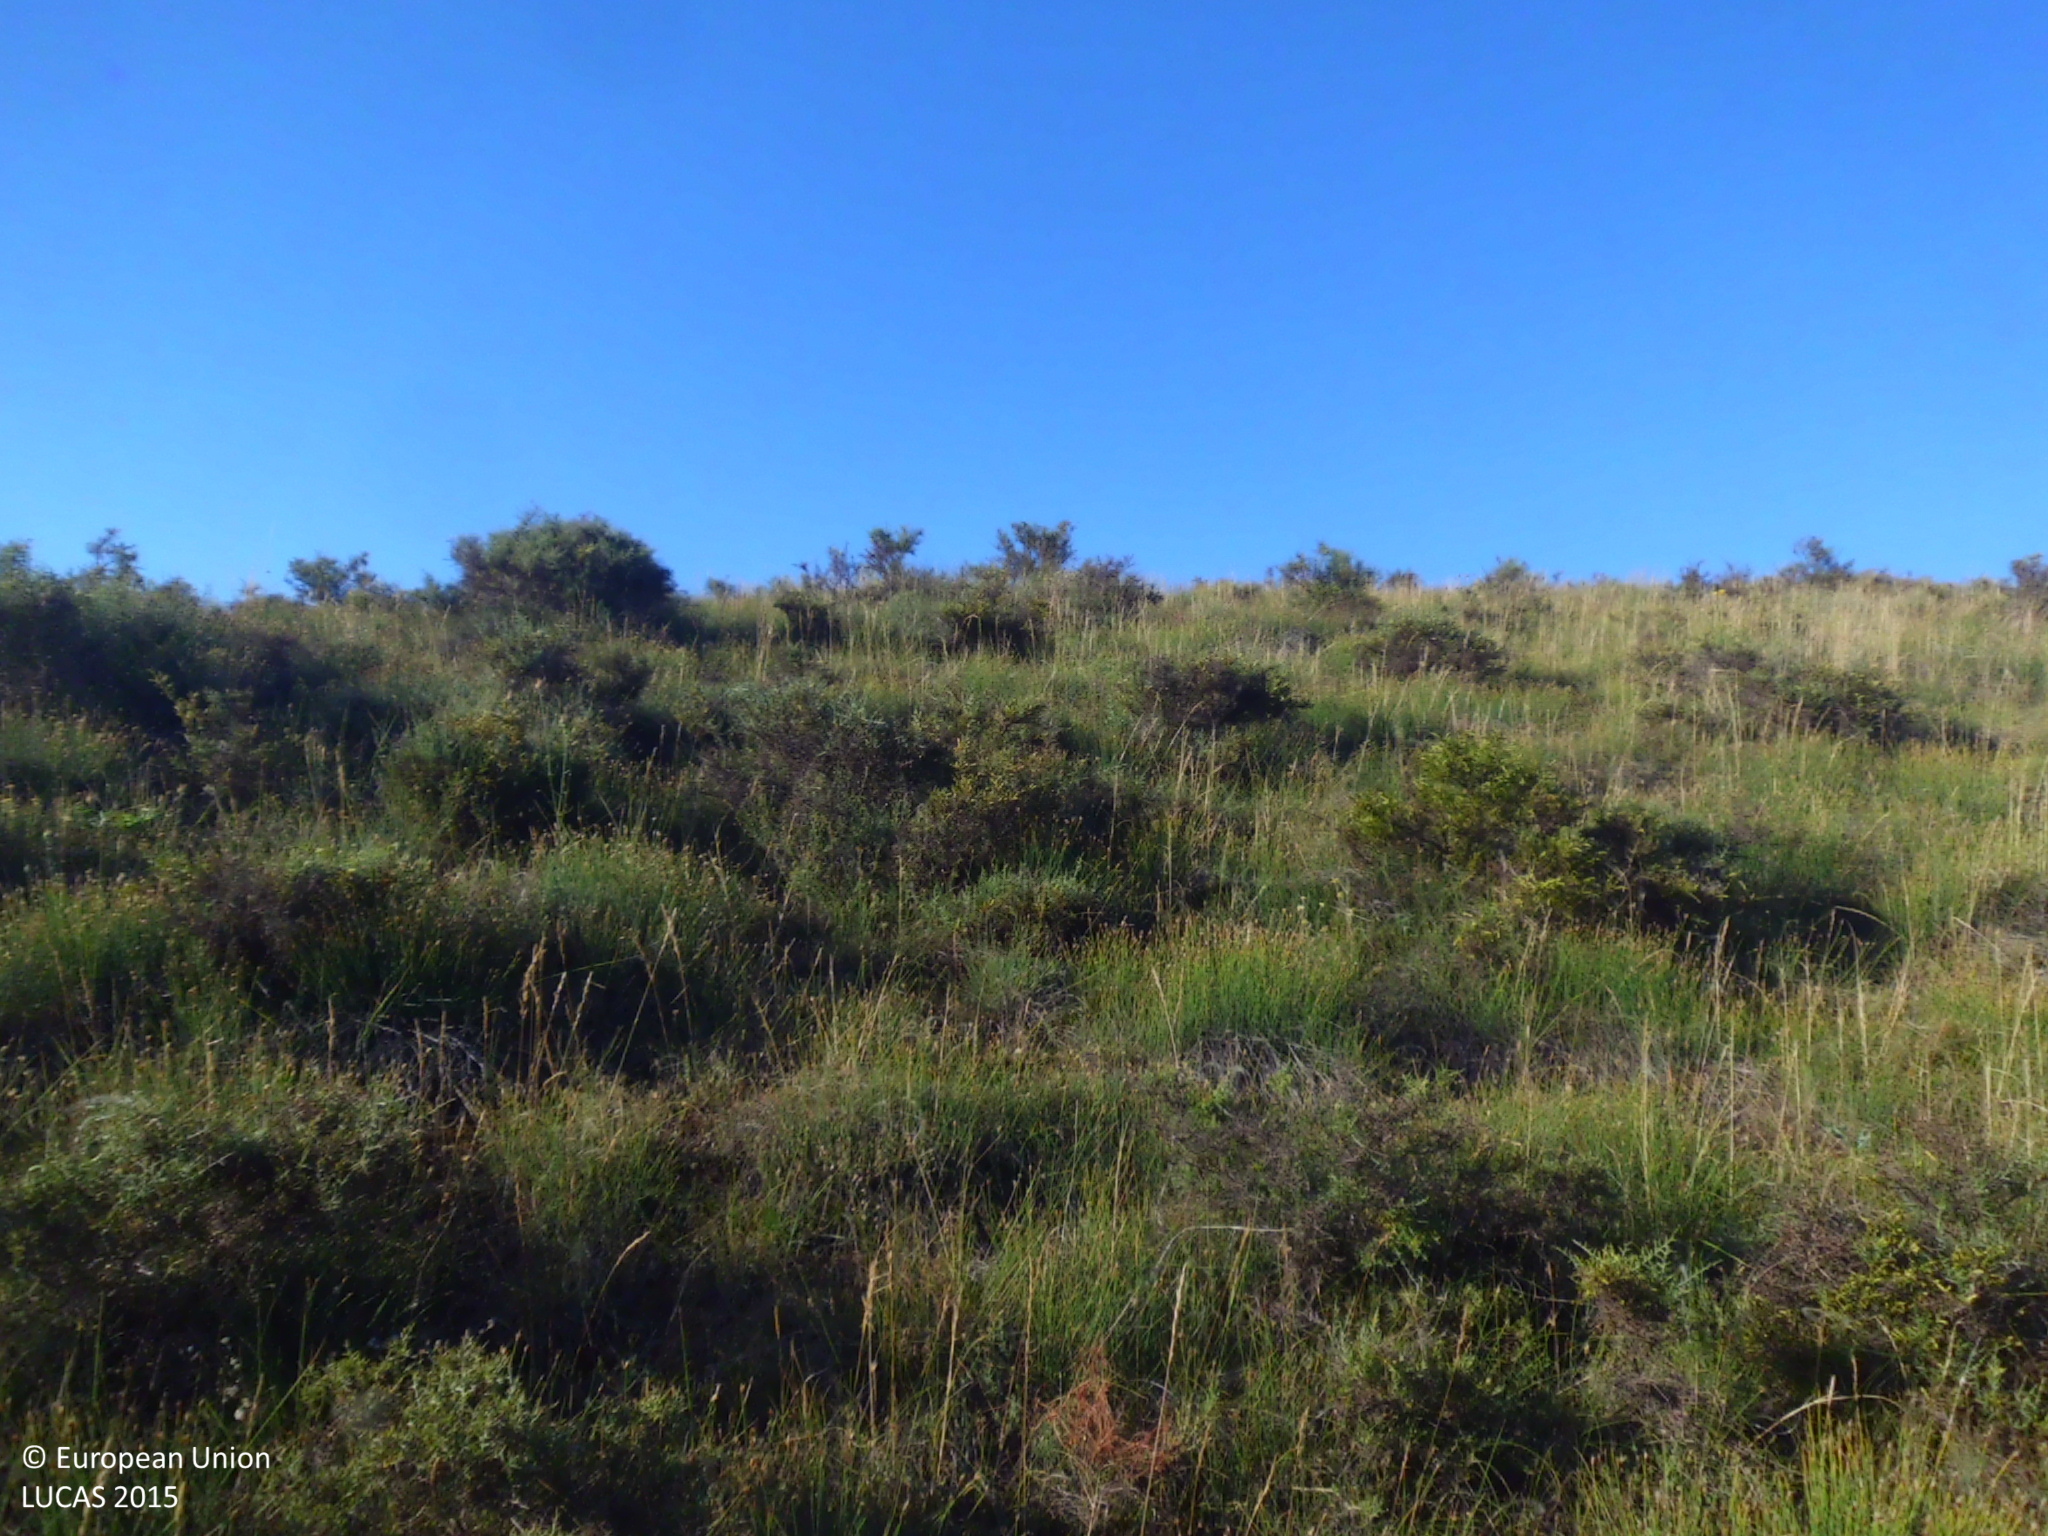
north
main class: Shrubland
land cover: Shrubland without tree cover
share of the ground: 50 - 75 %
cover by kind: shrubs 60 %, herbaceous plants 30 %, consolidated bare surface 10 %
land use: Semi-natural and natural areas not in use
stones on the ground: 25 - 50 %
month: July
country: ES
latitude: 42.6287
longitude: -4.2537
